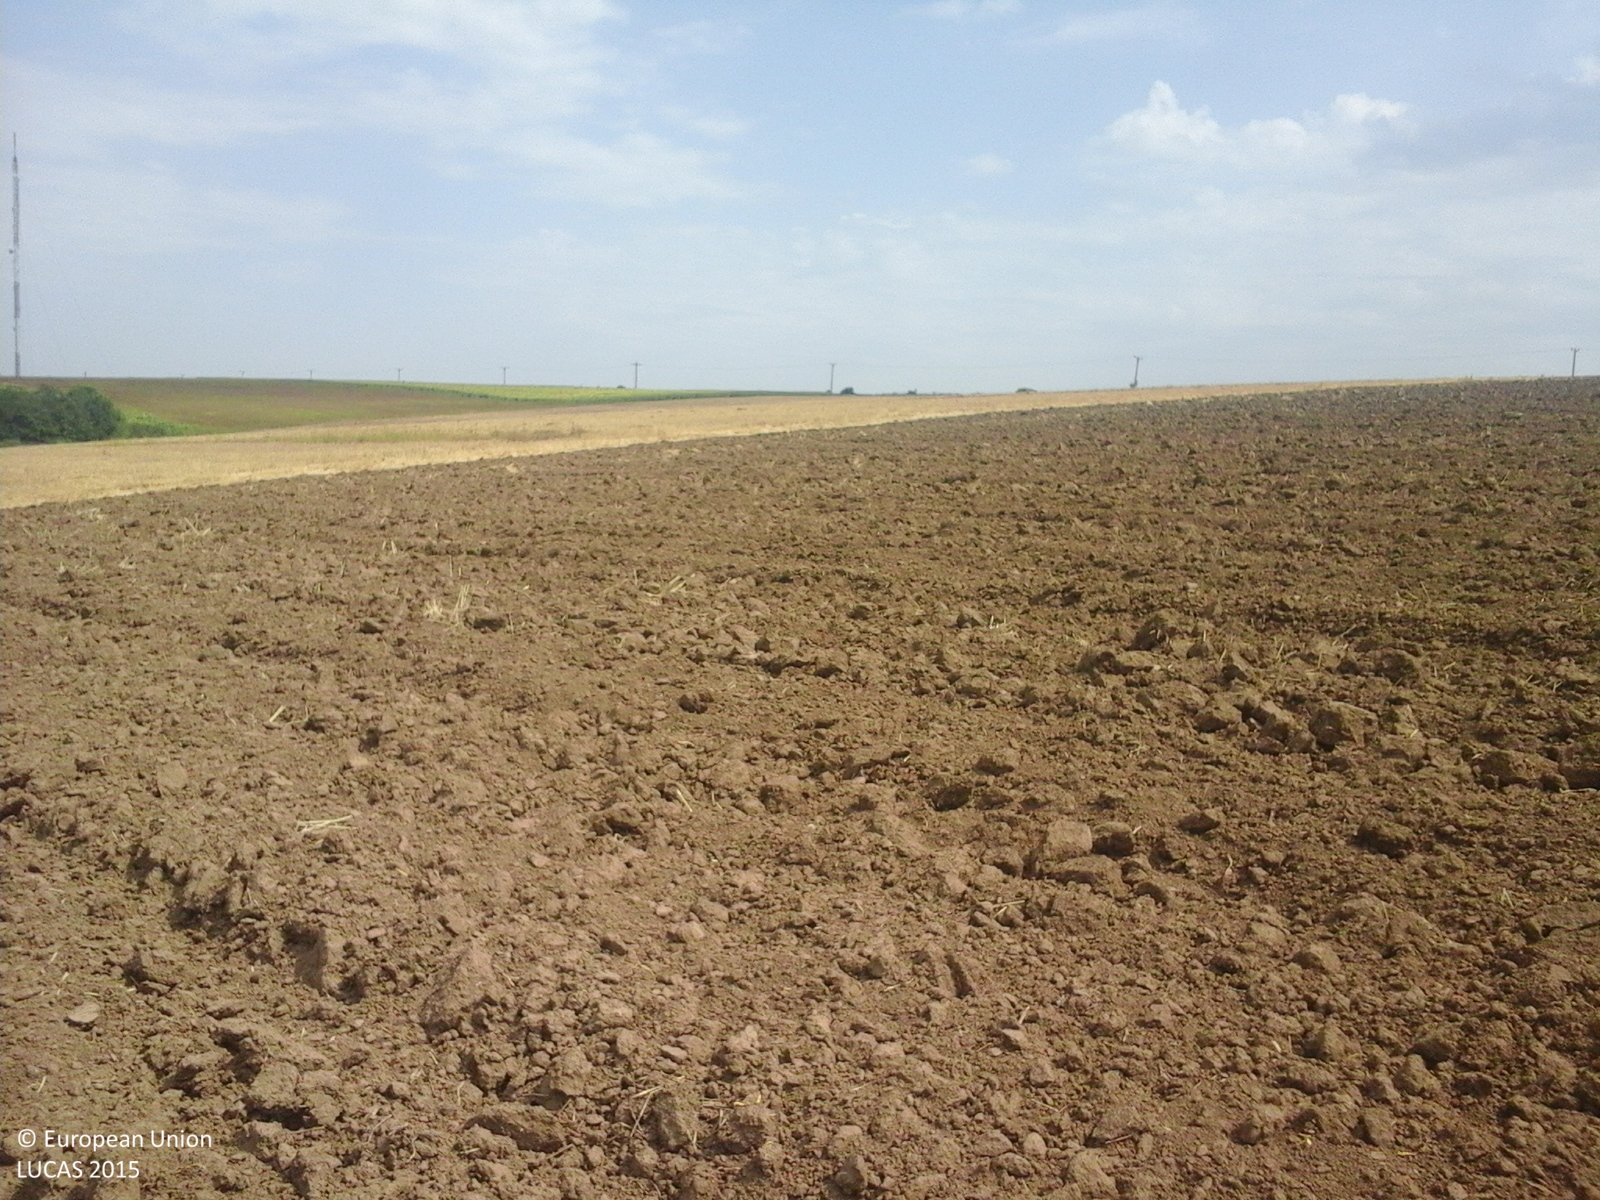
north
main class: Cropland
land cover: Common wheat
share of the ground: < 10 %
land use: Agriculture (excluding fallow land and kitchen gardens)
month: August
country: RO
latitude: 44.0397
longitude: 27.7531
